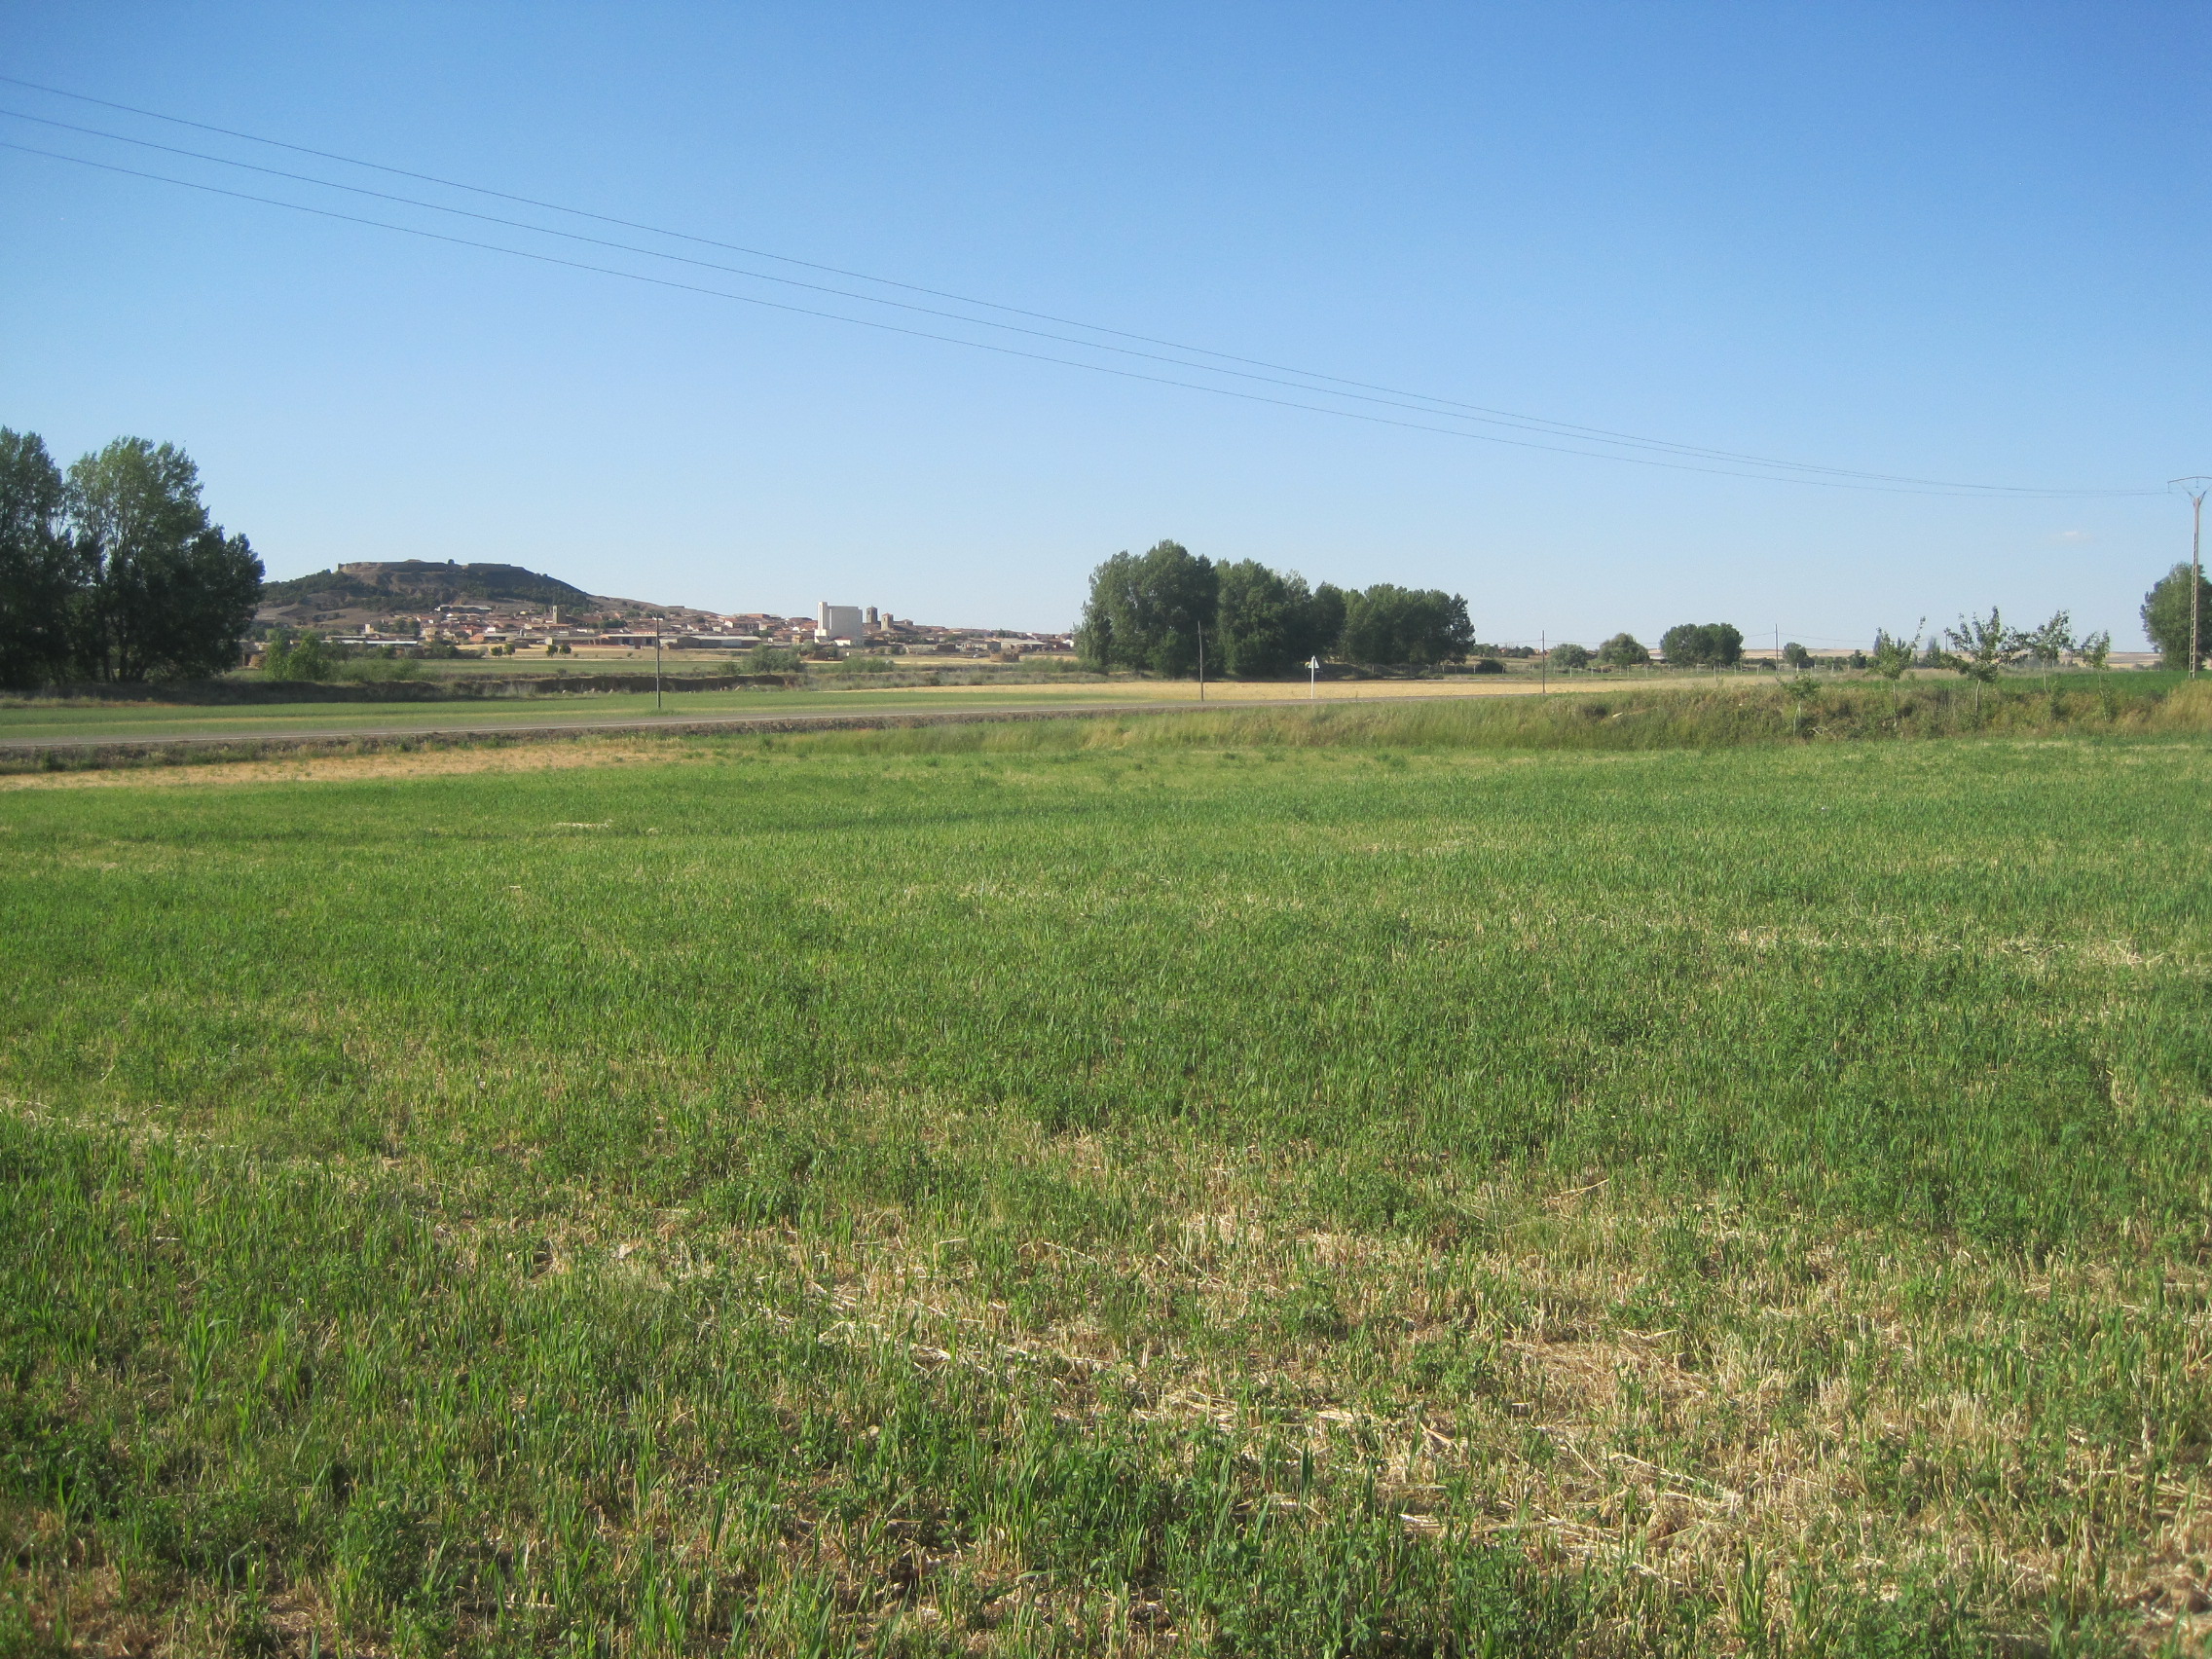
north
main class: Cropland
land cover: Mixed cereals for fodder
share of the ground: > 75 %
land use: Agriculture (excluding fallow land and kitchen gardens)
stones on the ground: 10 - 25 %
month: June
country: ES
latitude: 41.7990
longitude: -5.1587
